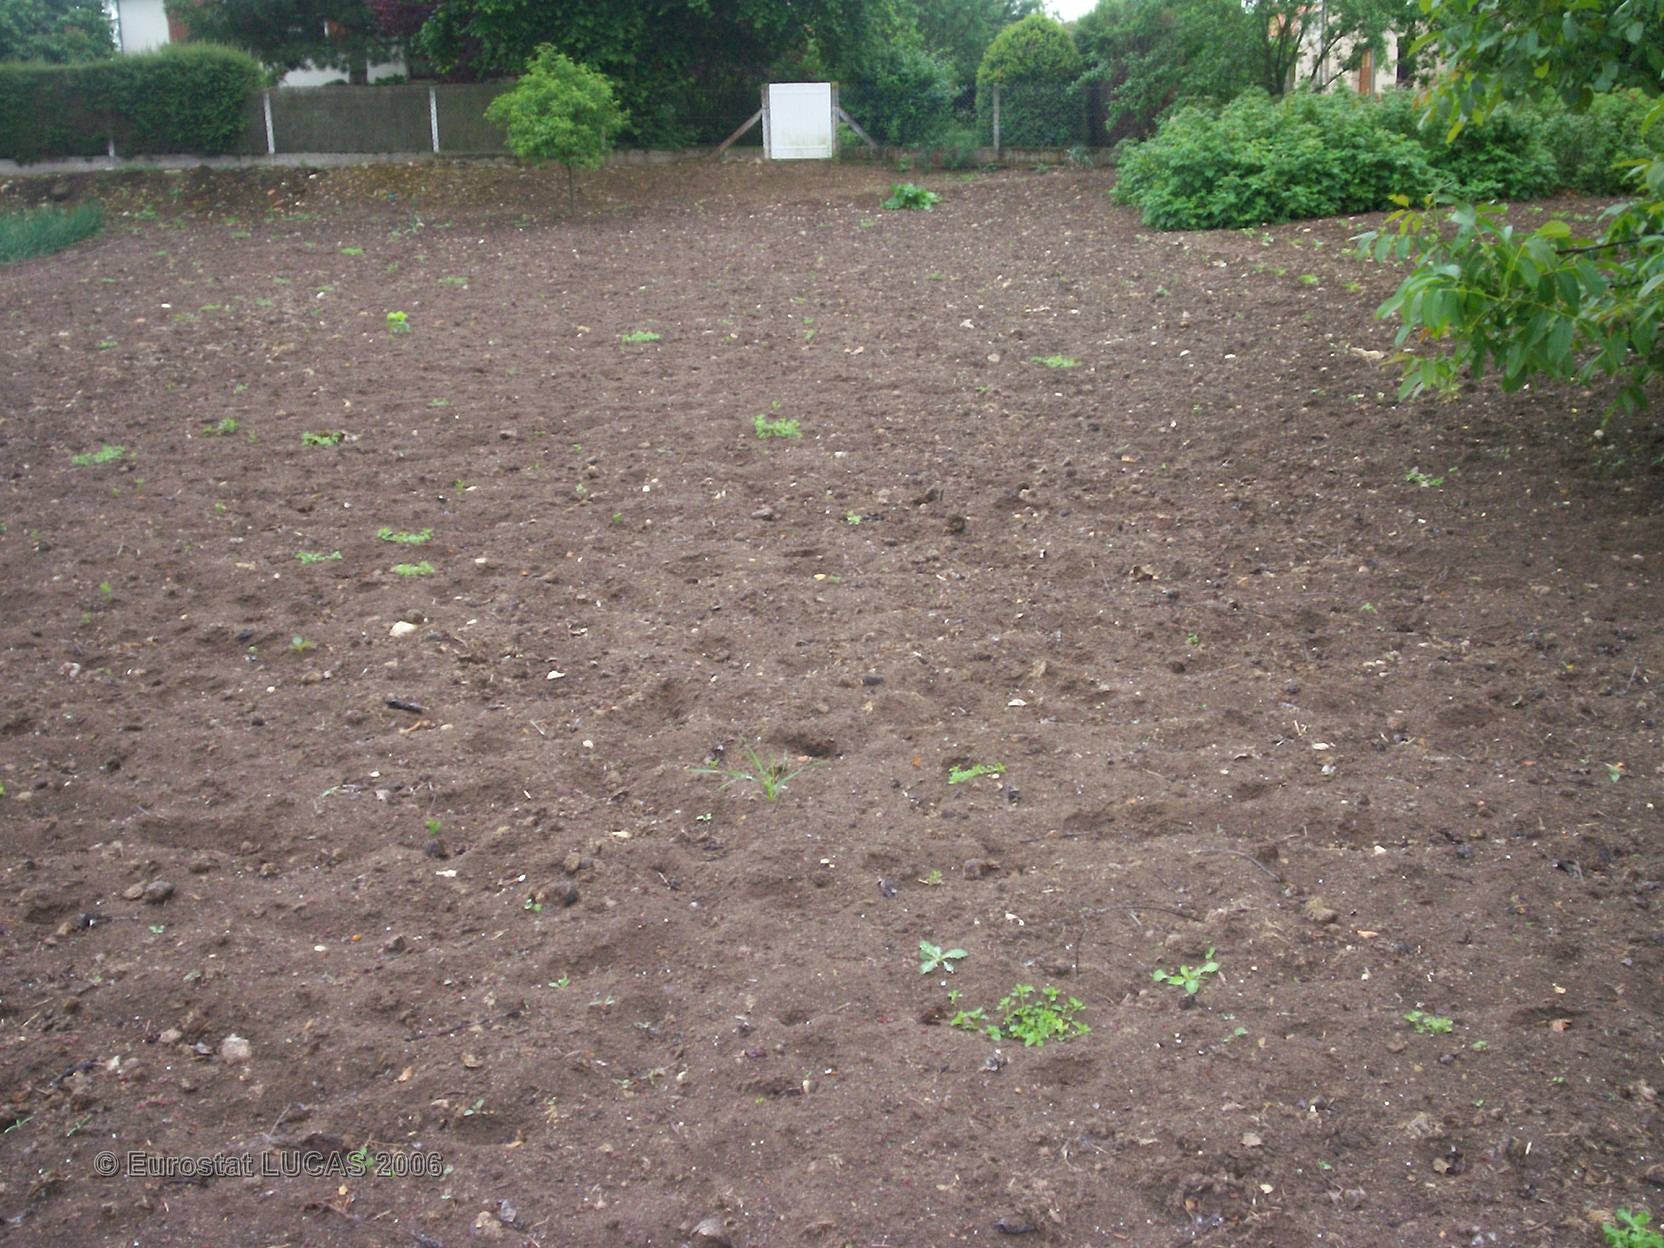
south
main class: Cropland
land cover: Other fresh vegetables
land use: Kitchen garden
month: May
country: FR
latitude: 46.7202
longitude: 0.4436
